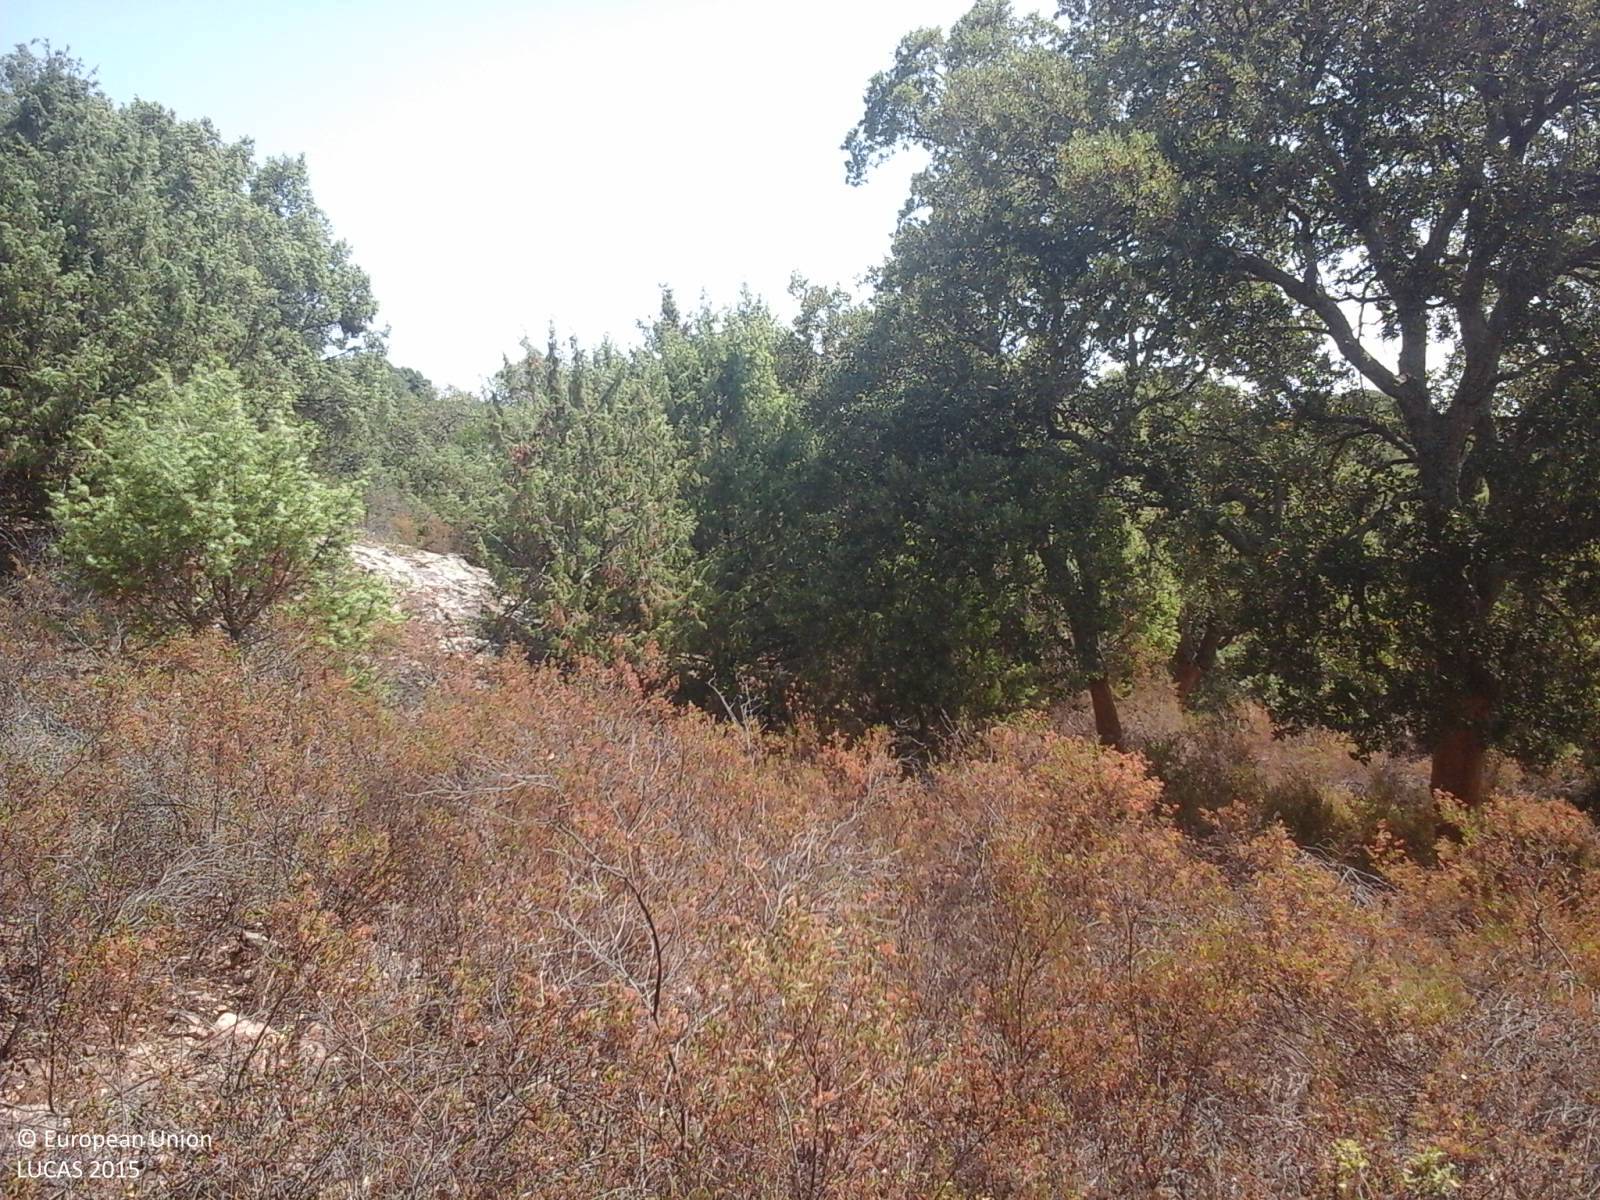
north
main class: Woodland
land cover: Broadleaved woodland
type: broadleaved evergreen forest
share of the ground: > 75 %
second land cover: Grassland without tree/shrub cover
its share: > 75 %
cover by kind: broadleaved forest trees 90 %, herbaceous plants 5 %, unconsolidated bare surface 5 %
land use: Forestry
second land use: Agriculture (excluding fallow land and kitchen gardens)
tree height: > 5 m
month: July
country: IT
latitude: 40.7912
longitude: 9.5636
